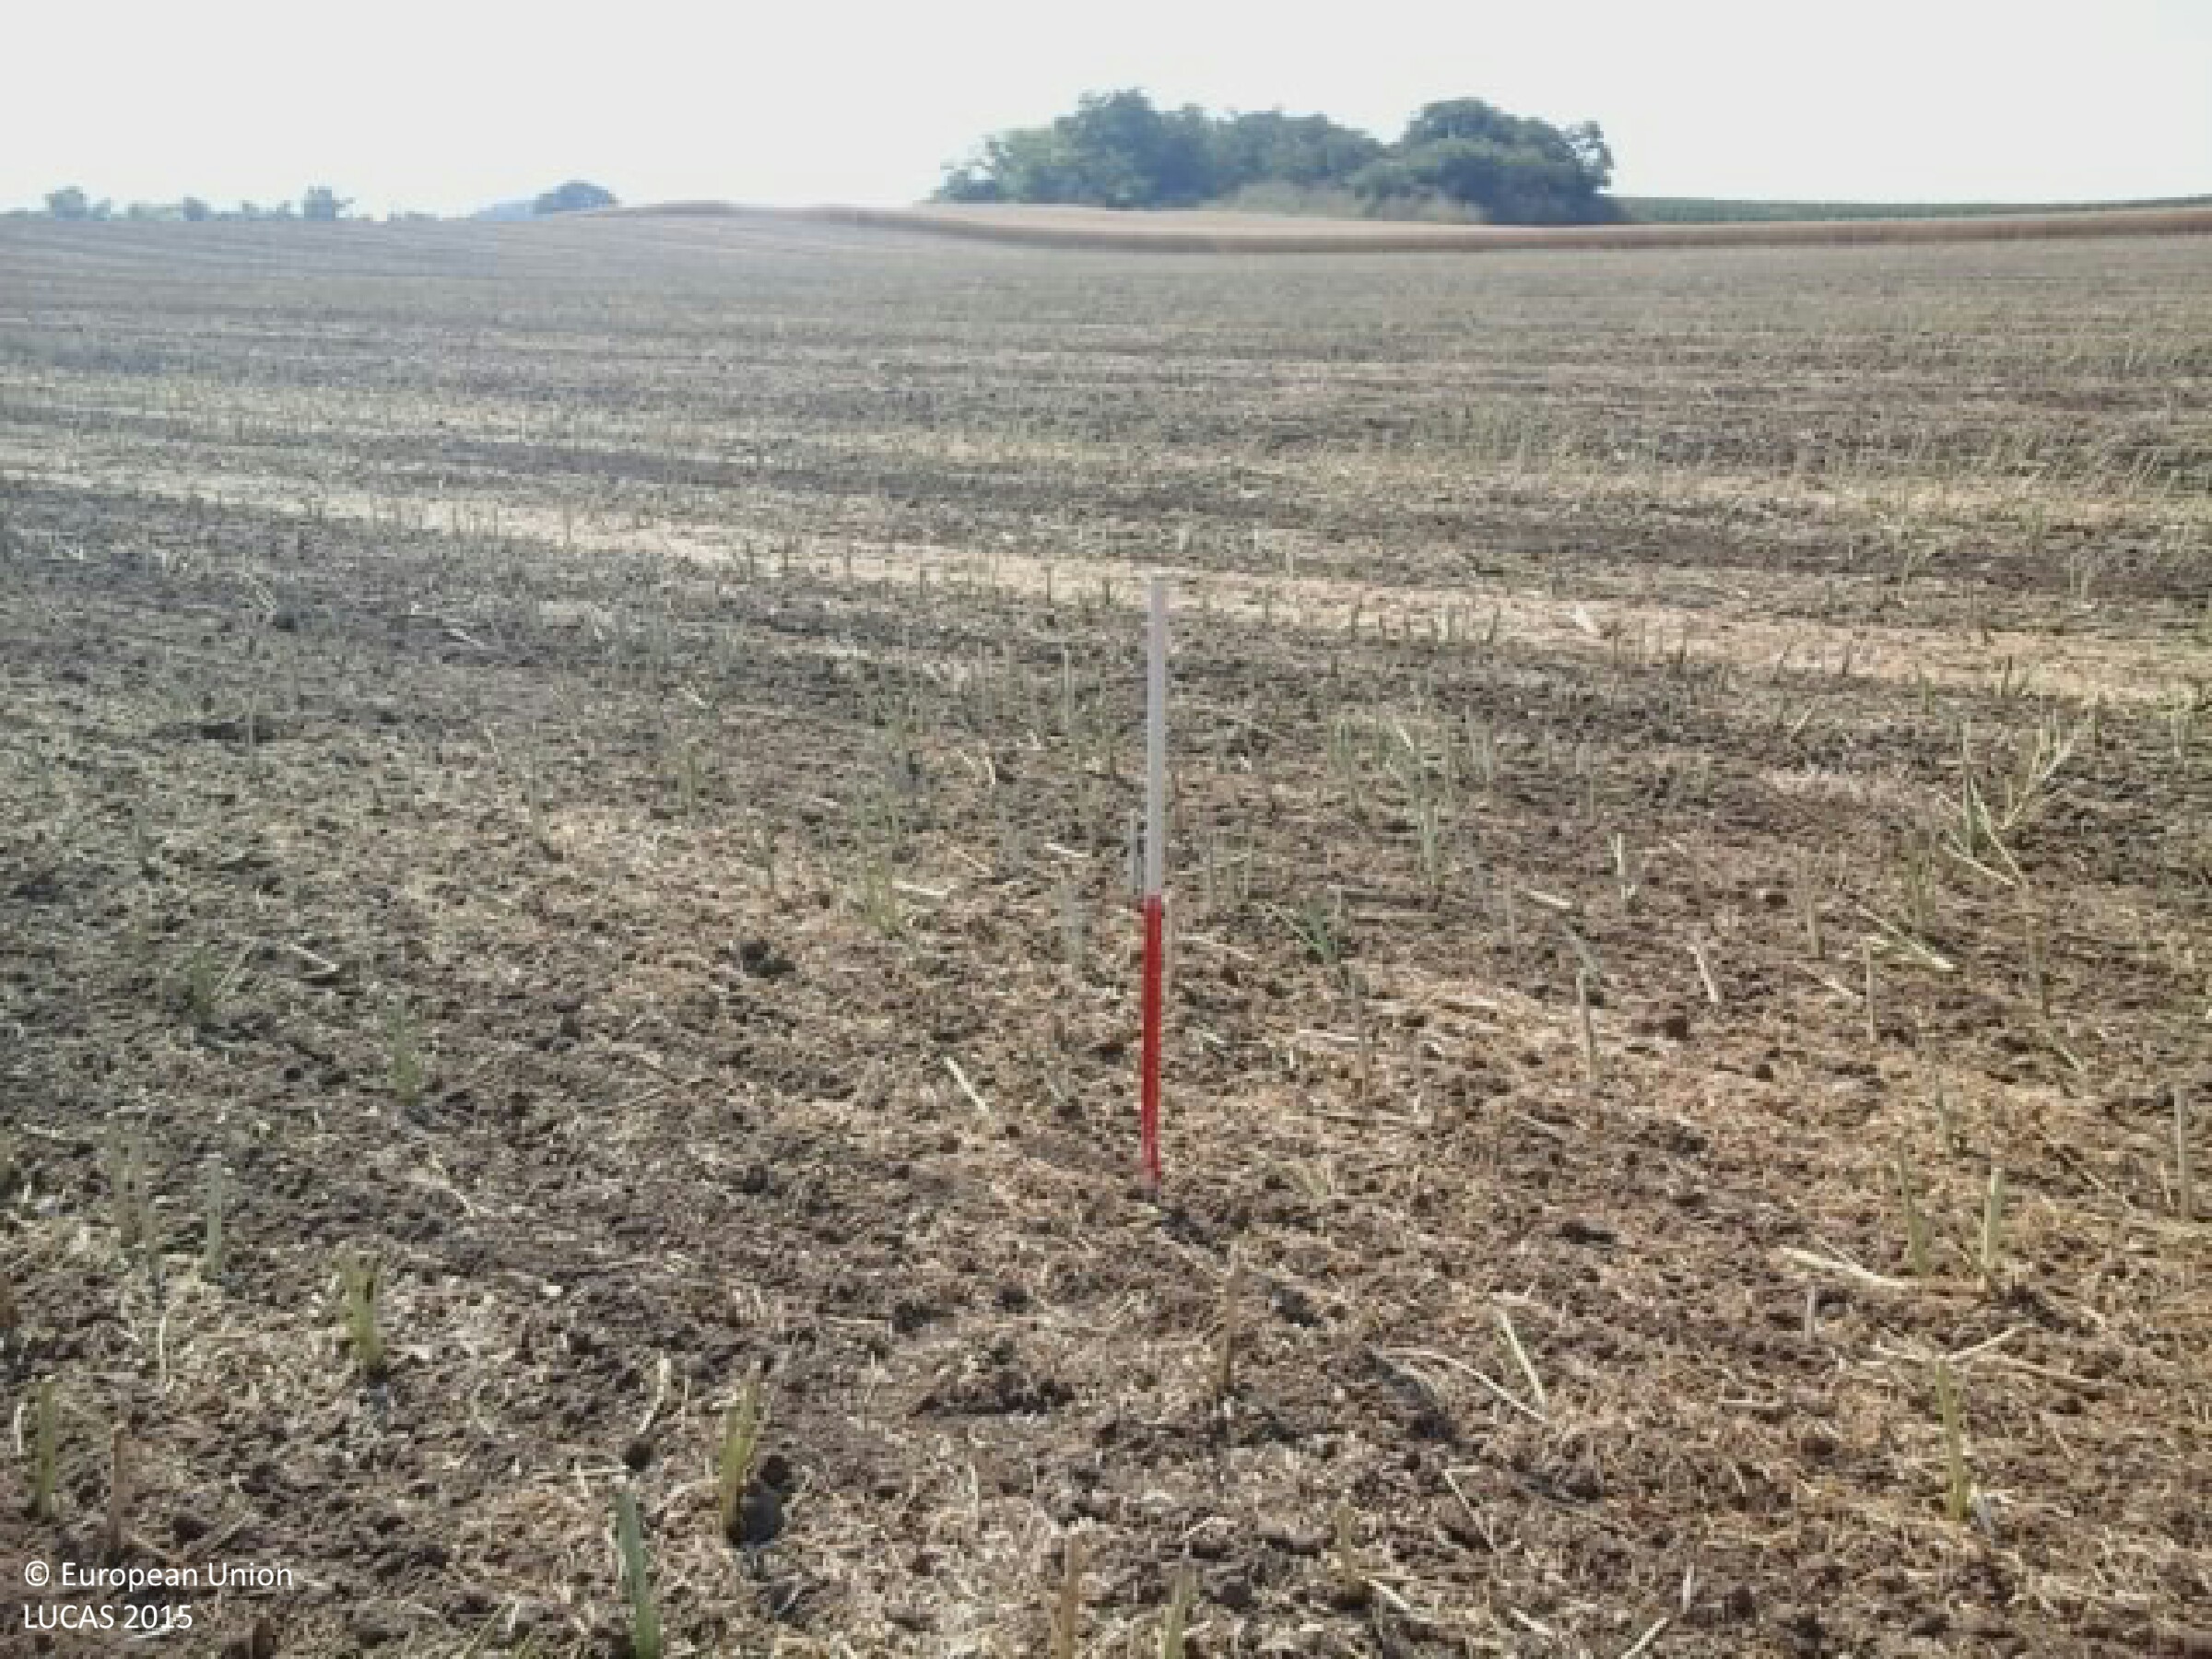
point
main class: Cropland
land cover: Rape and turnip rape
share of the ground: < 10 %
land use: Agriculture (excluding fallow land and kitchen gardens)
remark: Harvested field
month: July
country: HU
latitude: 46.1561
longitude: 19.1683
